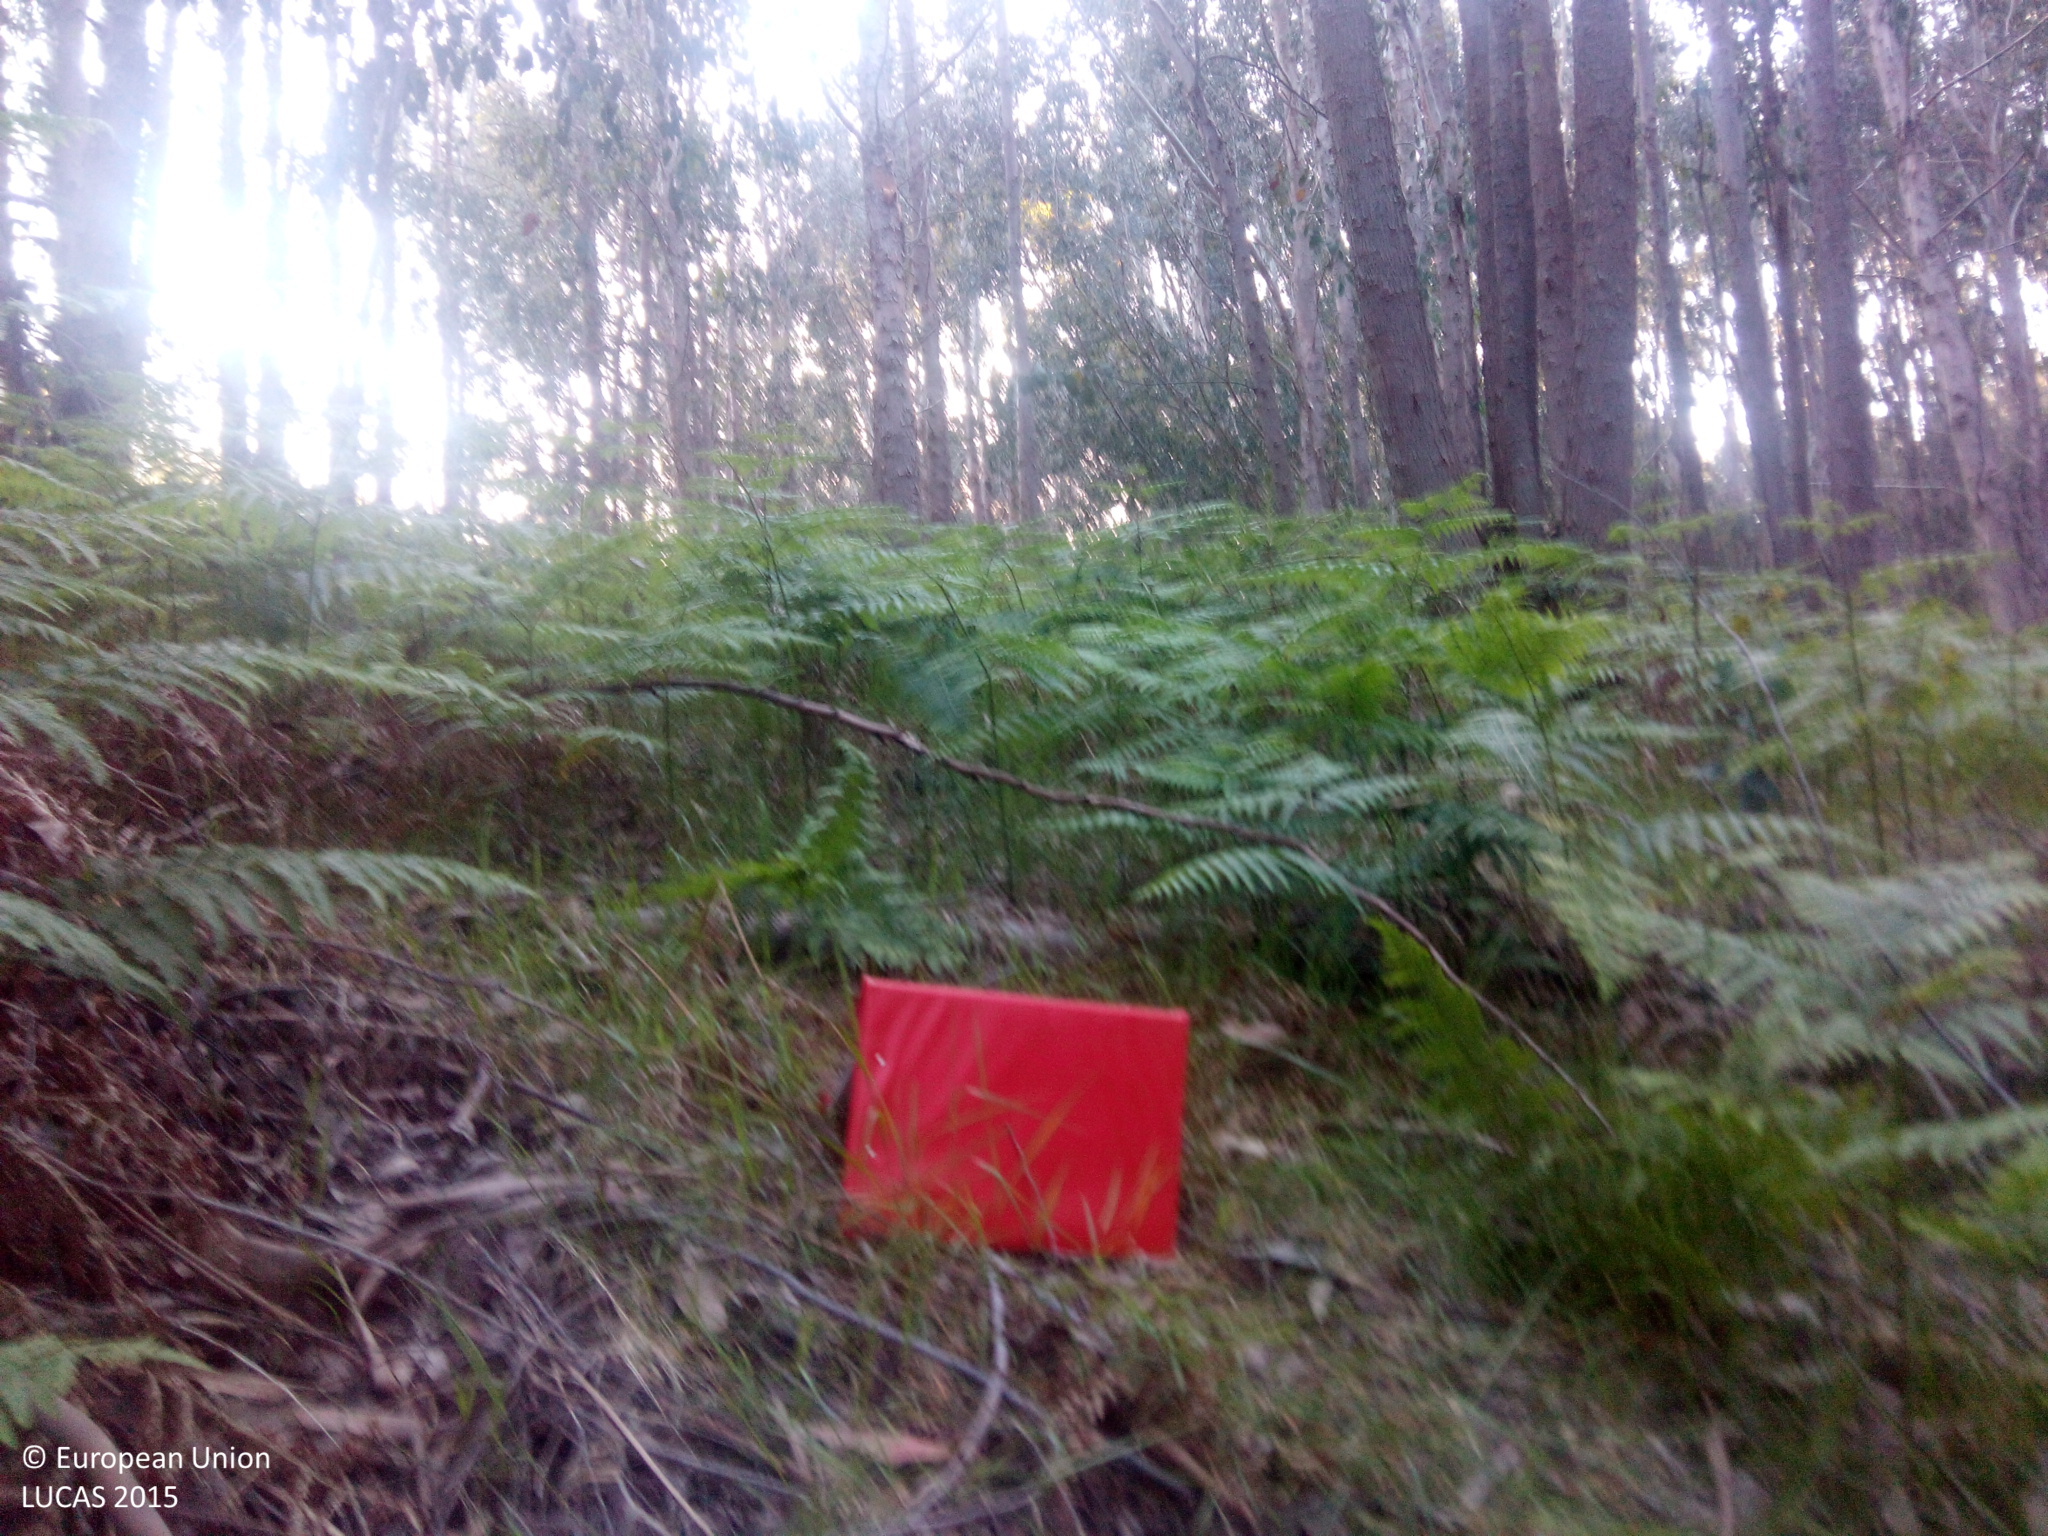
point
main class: Woodland
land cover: Broadleaved woodland
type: exotic forest
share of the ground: > 75 %
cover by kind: broadleaved forest trees 70 %, shrubs 20 %, herbaceous plants 10 %
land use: Forestry
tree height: > 5 m
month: June
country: ES
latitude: 42.2218
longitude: -8.3218
